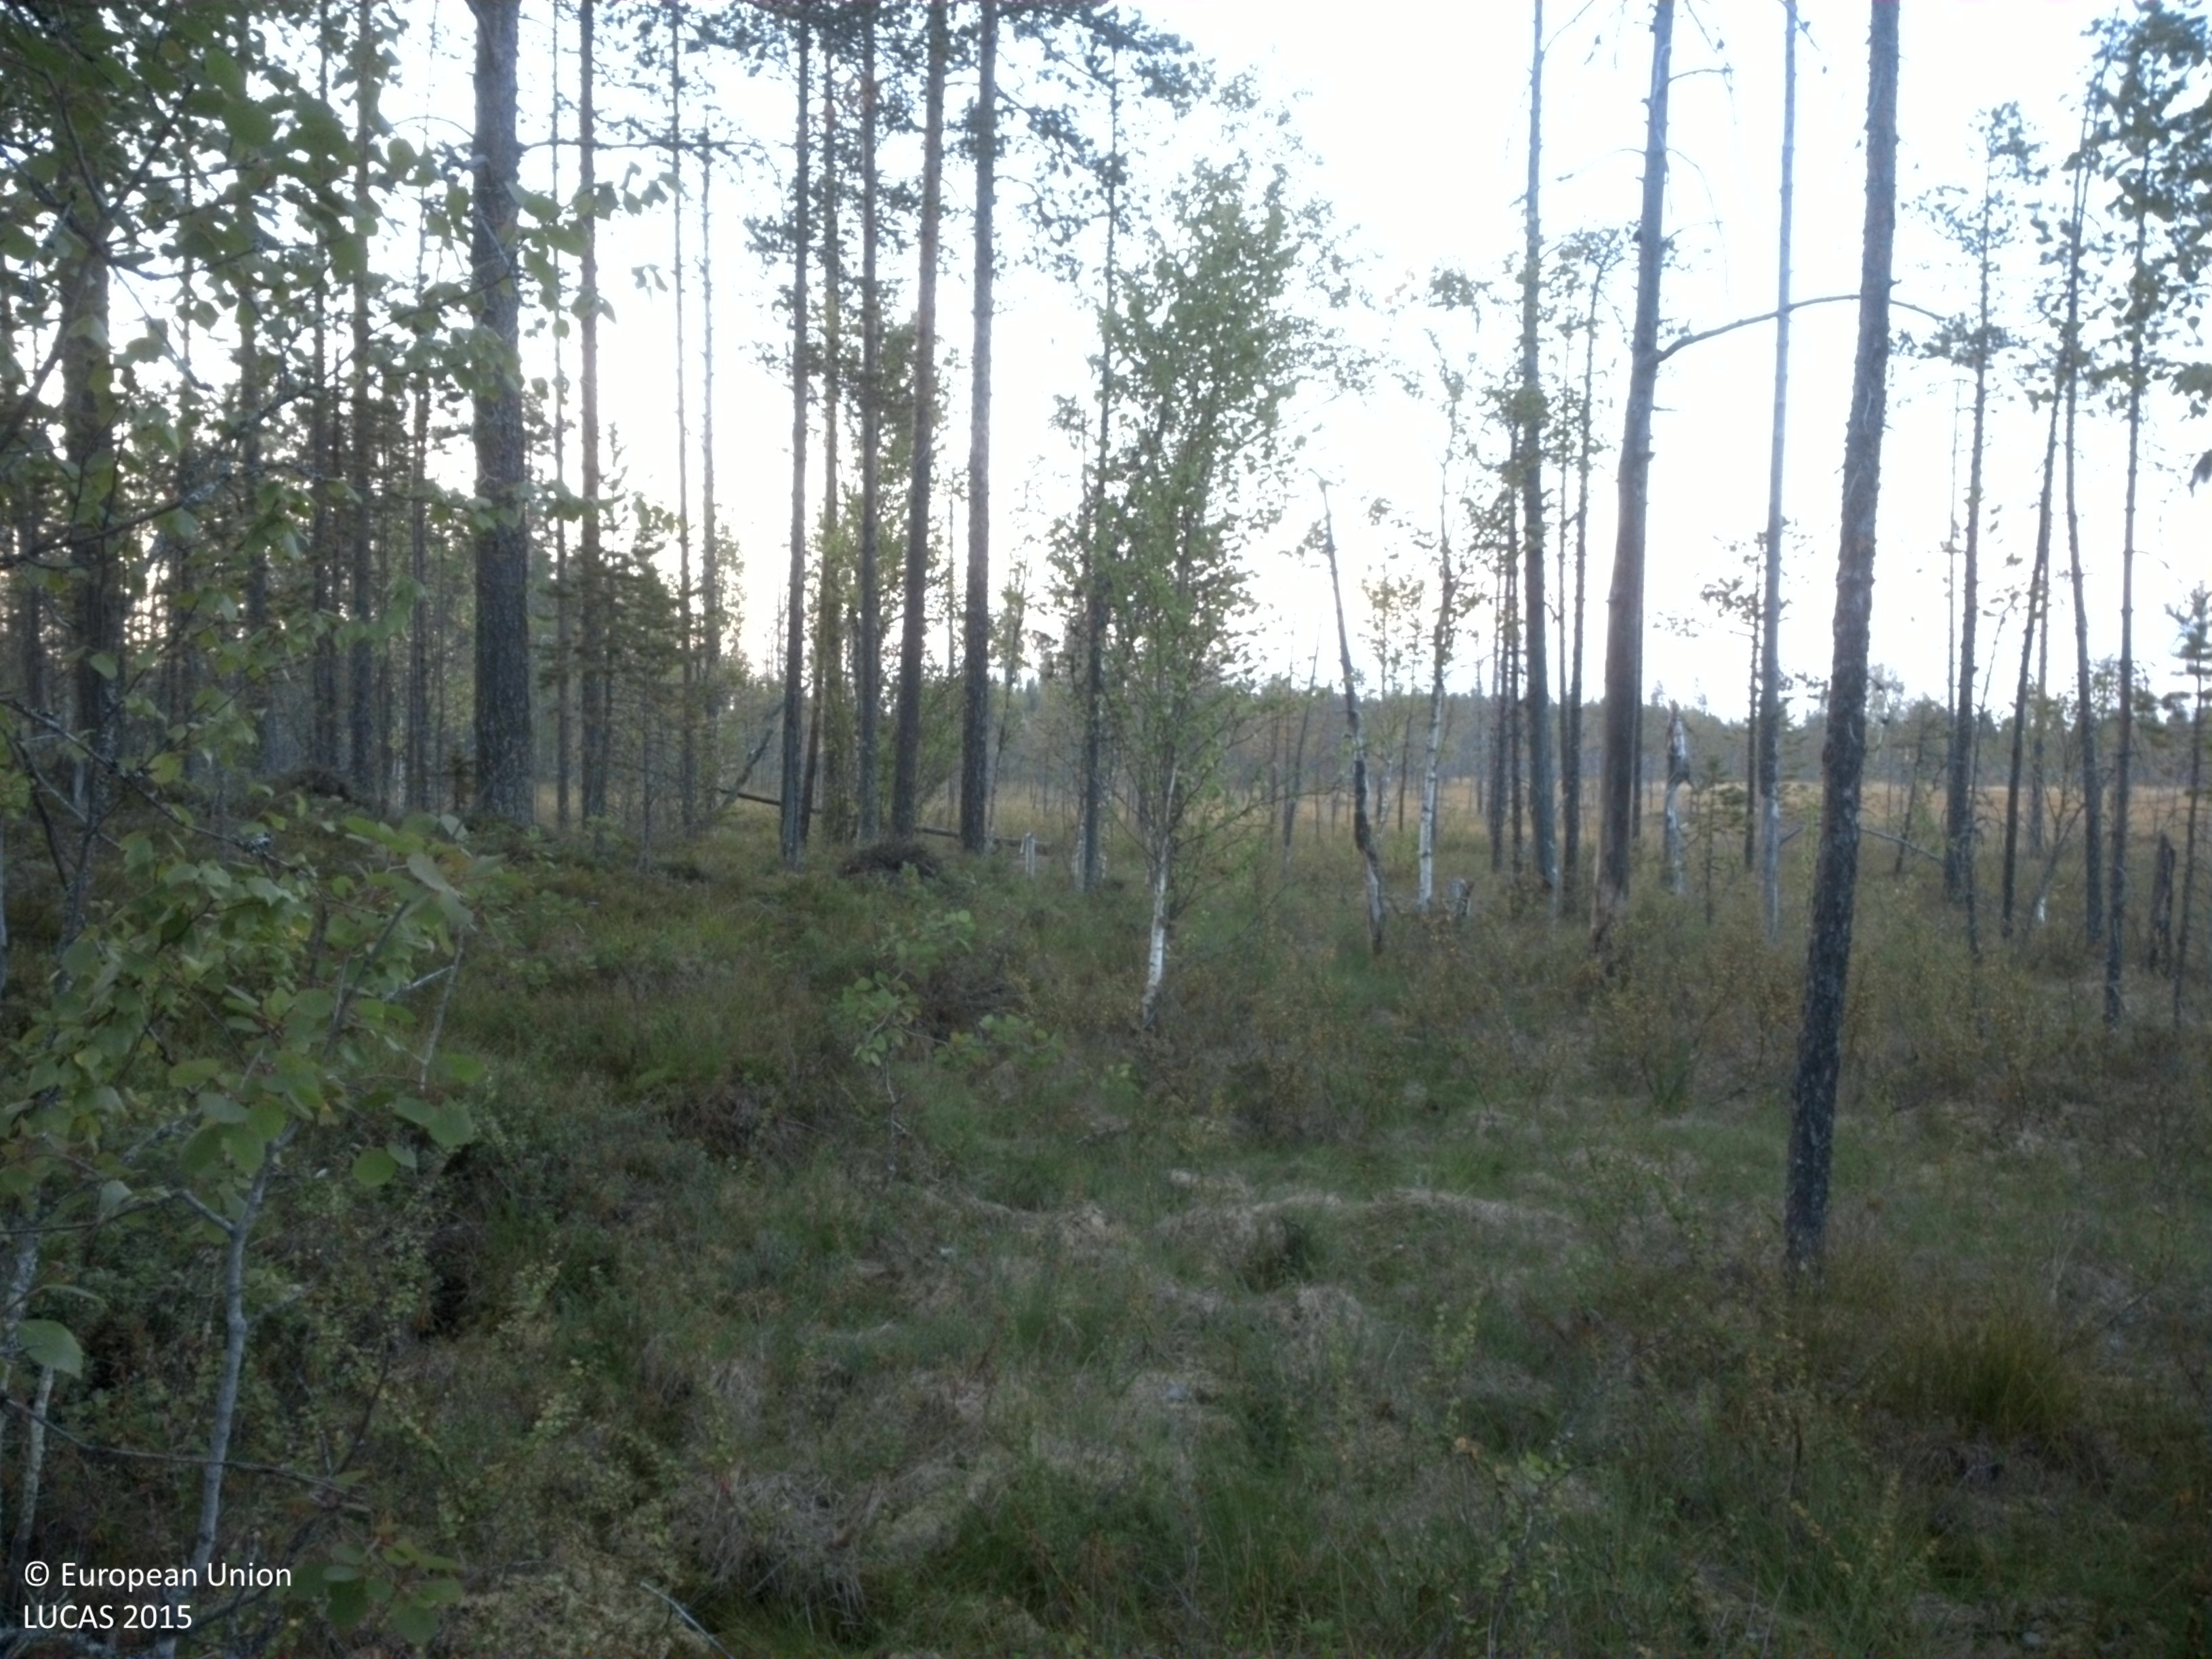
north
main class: Woodland
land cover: Pine dominated mixed woodland
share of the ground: 25 - 50 %
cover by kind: lichens and mosses 40 %, coniferous forest trees 30 %, broadleaved forest trees 10 %, shrubs 10 %, herbaceous plants 10 %
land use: Forestry
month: August
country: SE
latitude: 64.4938
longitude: 18.8985
